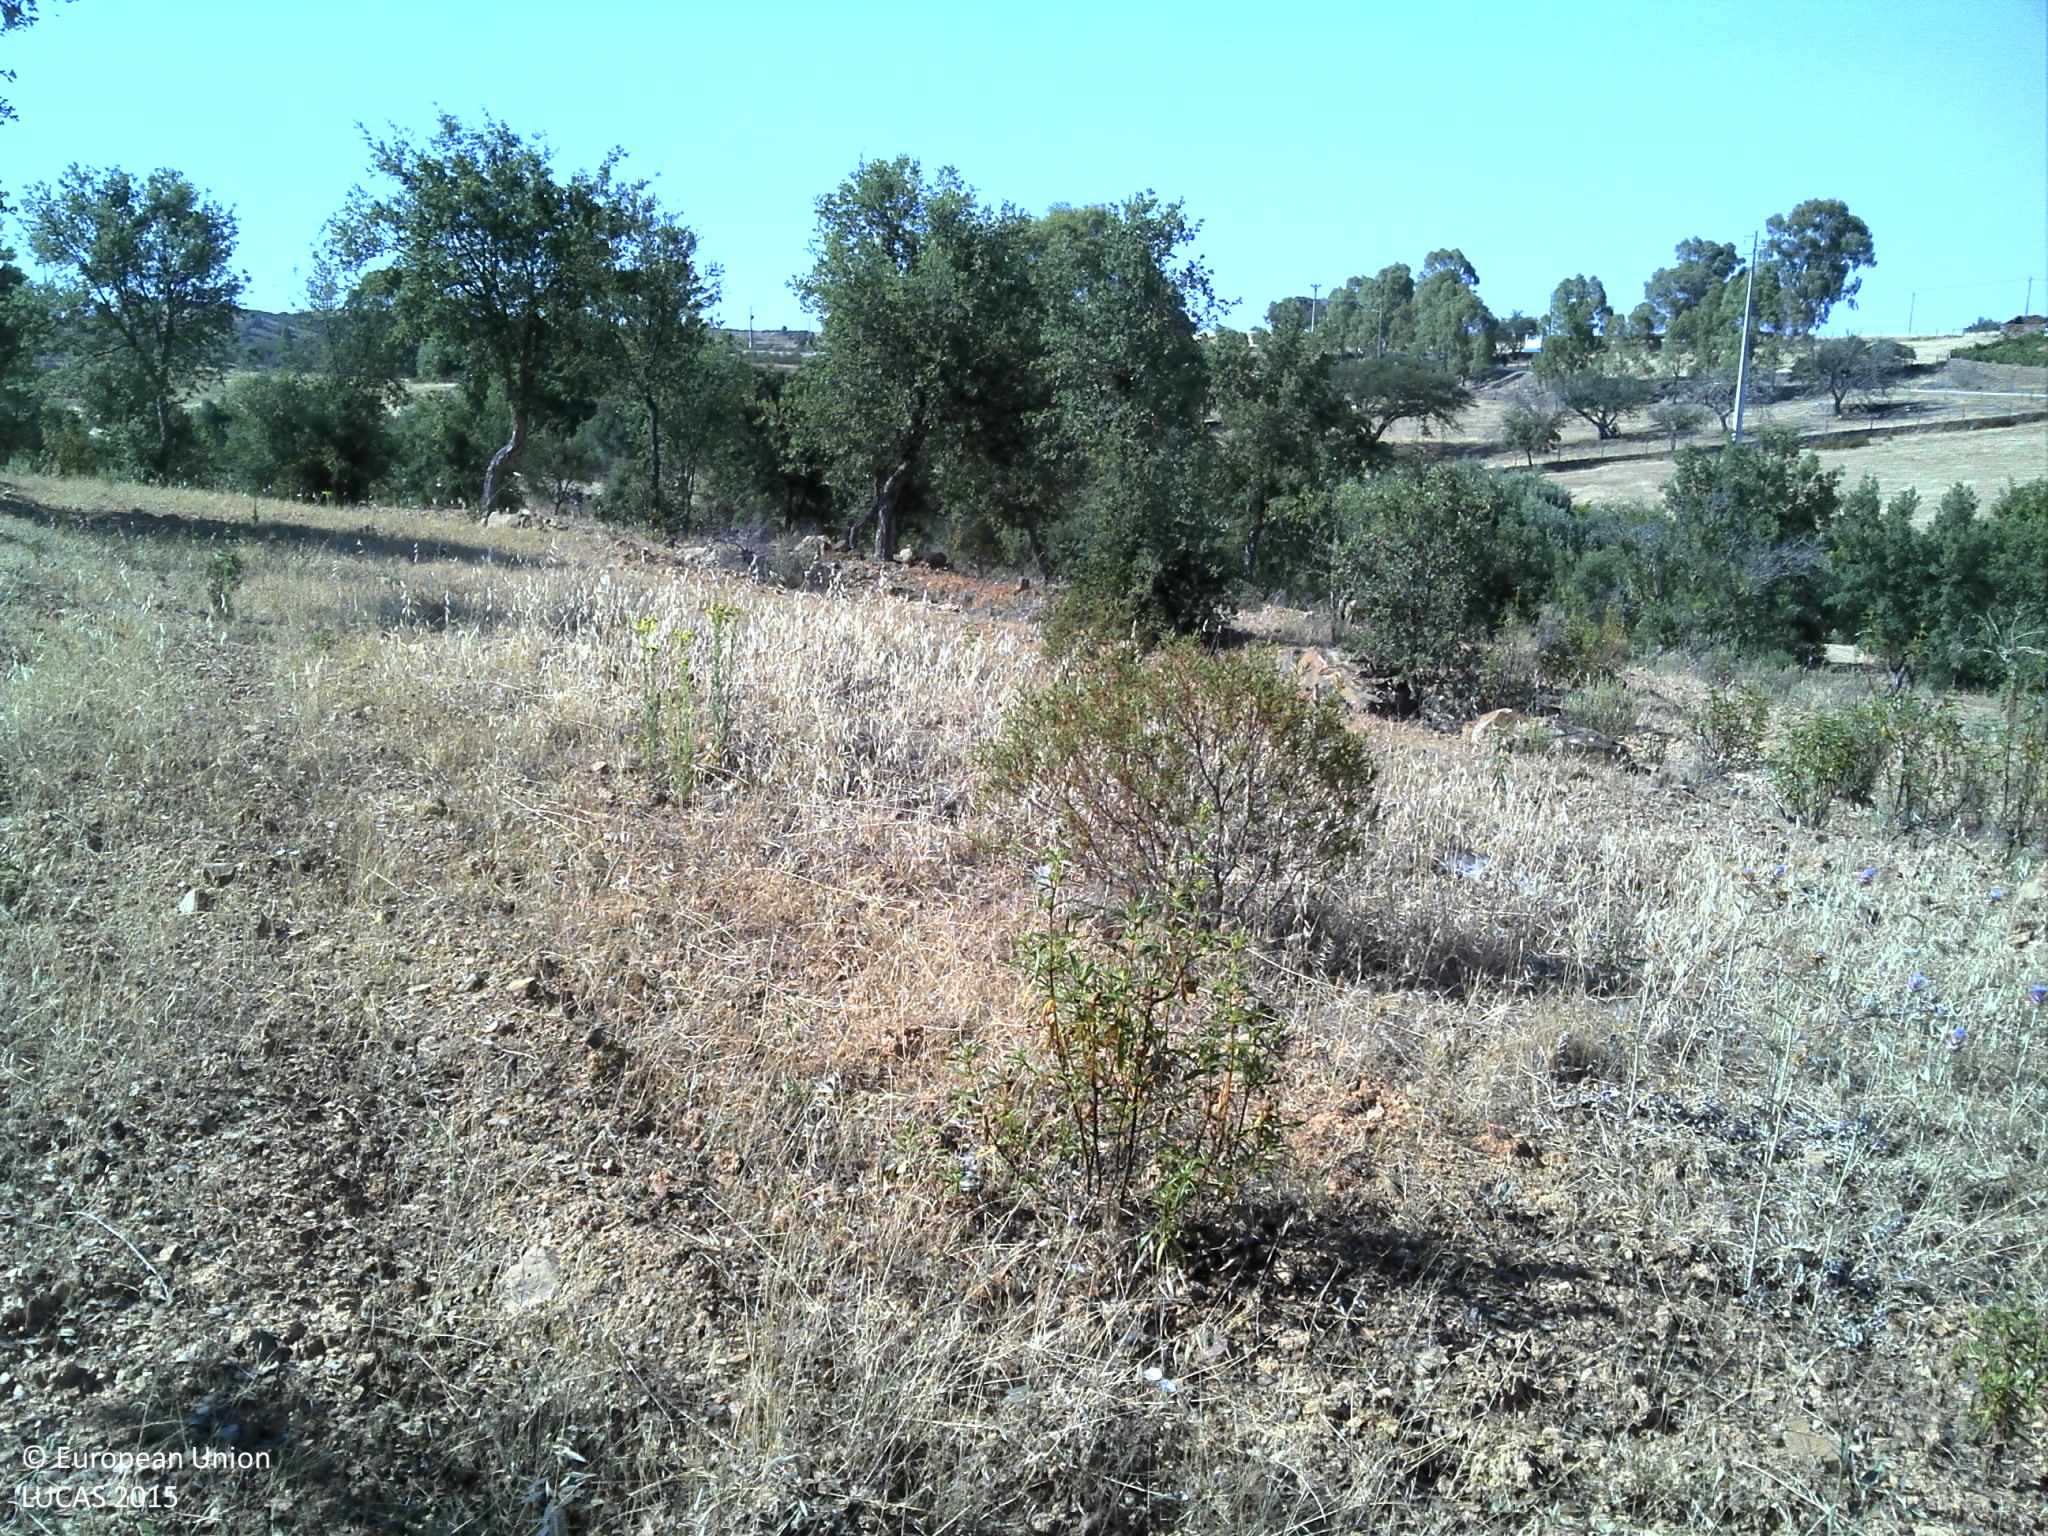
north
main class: Woodland
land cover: Broadleaved woodland
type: broadleaved evergreen forest
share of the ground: 25 - 50 %
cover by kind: broadleaved forest trees 35 %, herbaceous plants 30 %, unconsolidated bare surface 30 %, shrubs 5 %
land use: Forestry
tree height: > 5 m
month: June
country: PT
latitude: 37.4695
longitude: -7.8473
